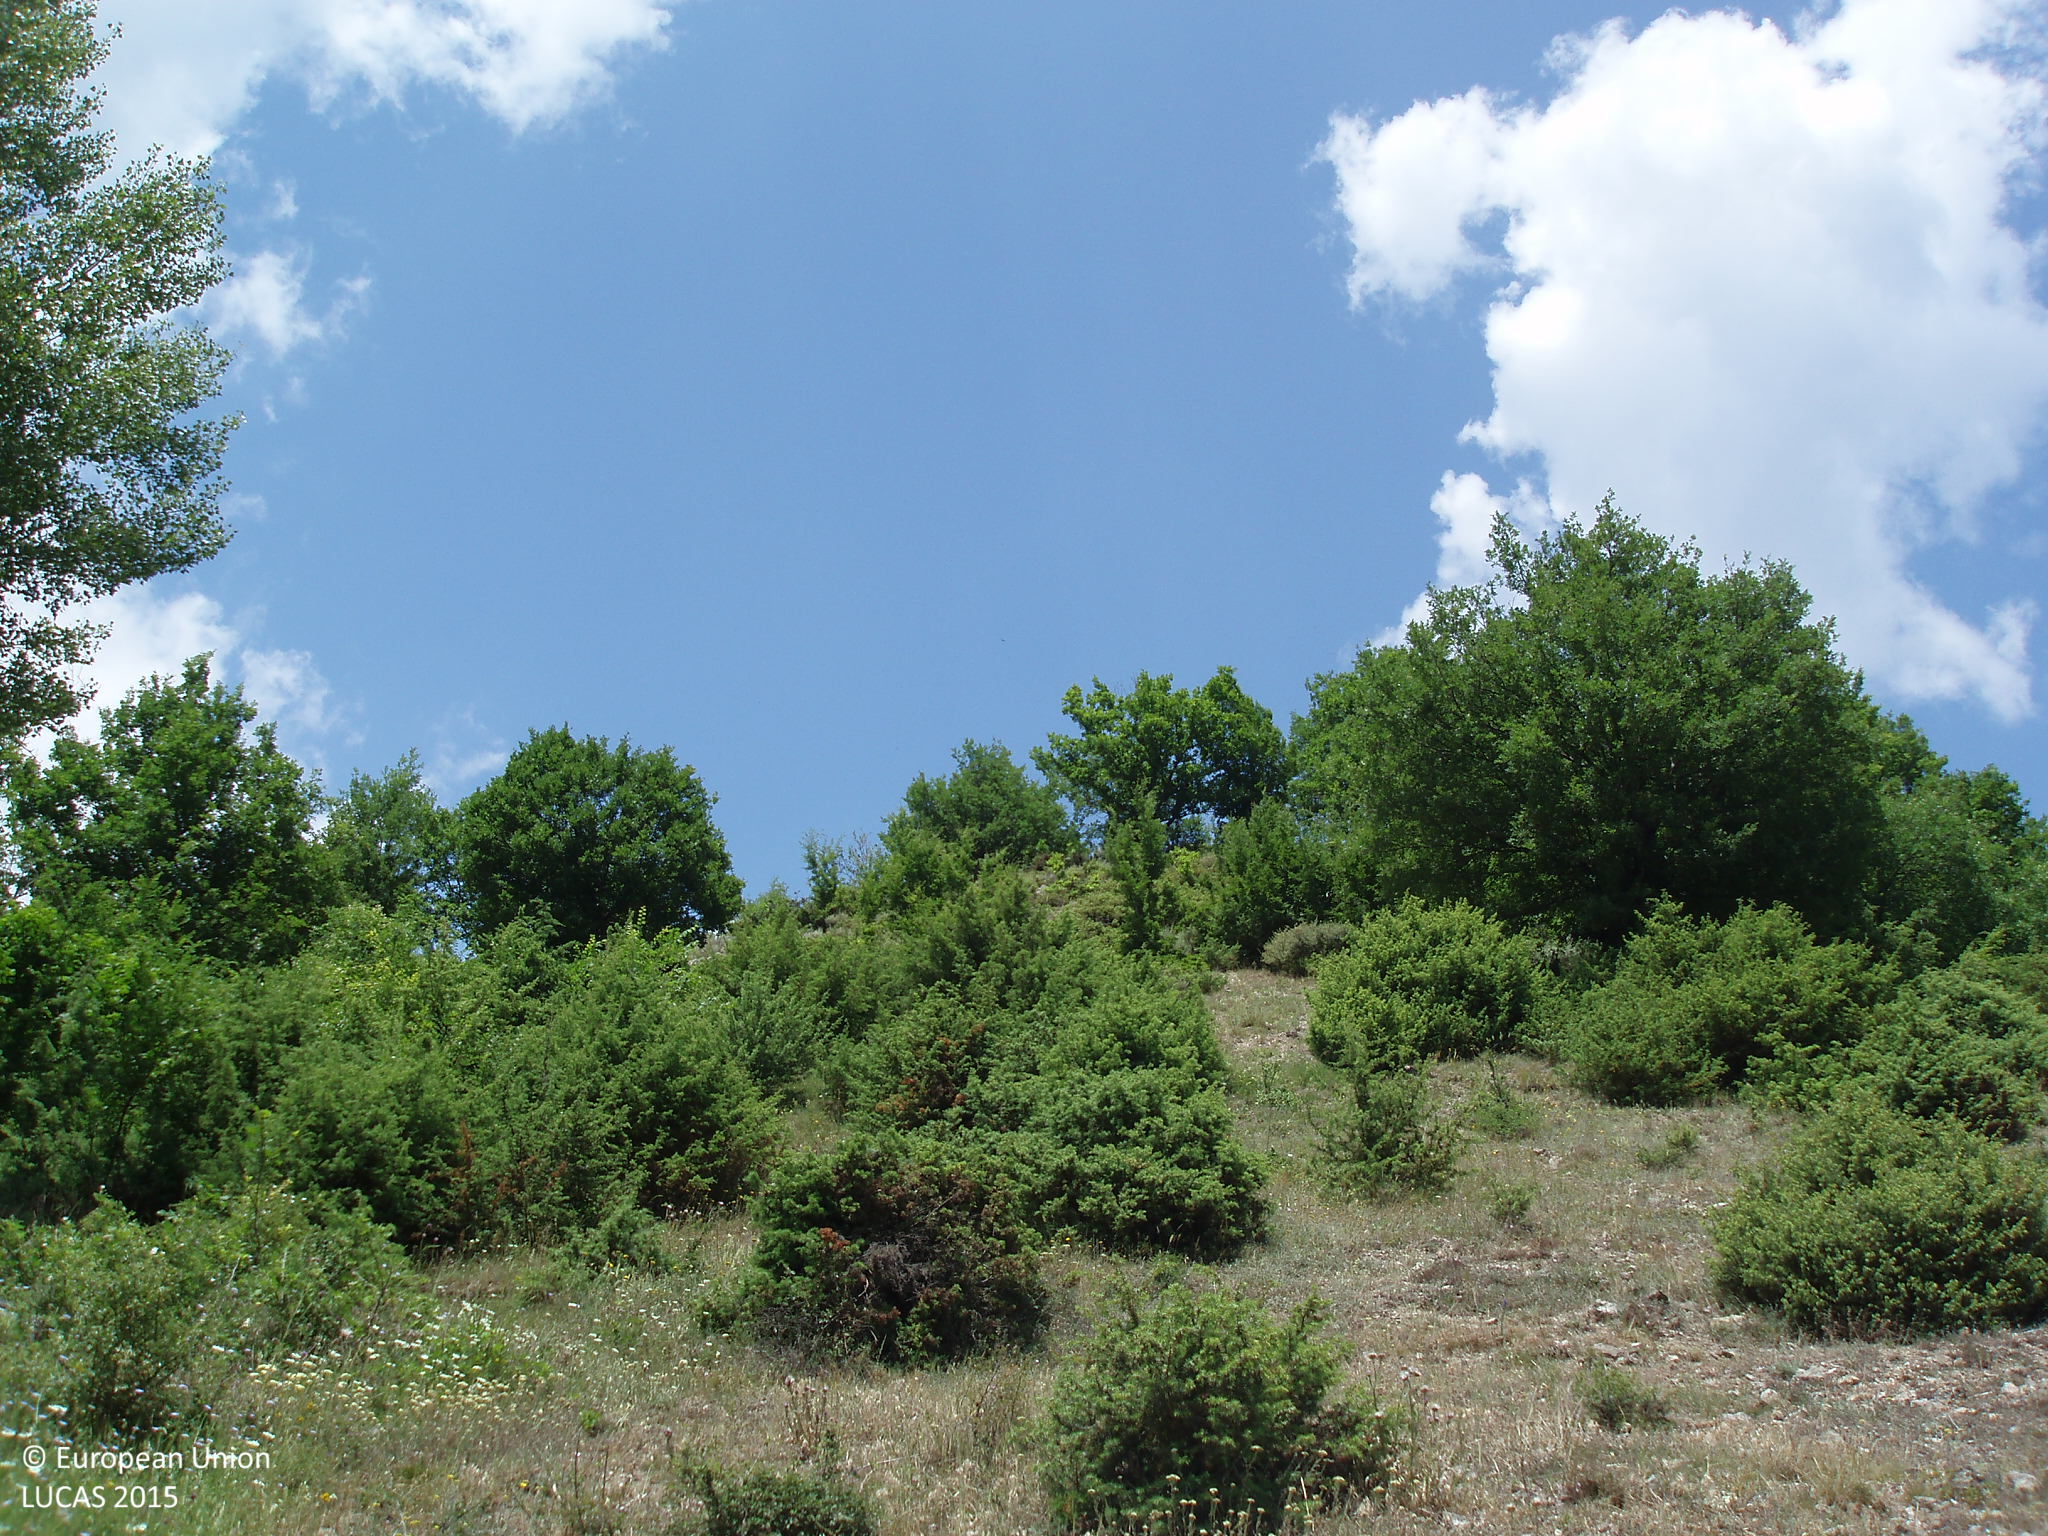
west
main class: Grassland
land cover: Grassland with sparse tree/shrub cover
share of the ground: > 75 %
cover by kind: herbaceous plants 90 %, broadleaved forest trees 5 %, shrubs 5 %
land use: Agriculture (excluding fallow land and kitchen gardens)
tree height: > 5 m
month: June
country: BG
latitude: 41.5913
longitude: 23.6917
